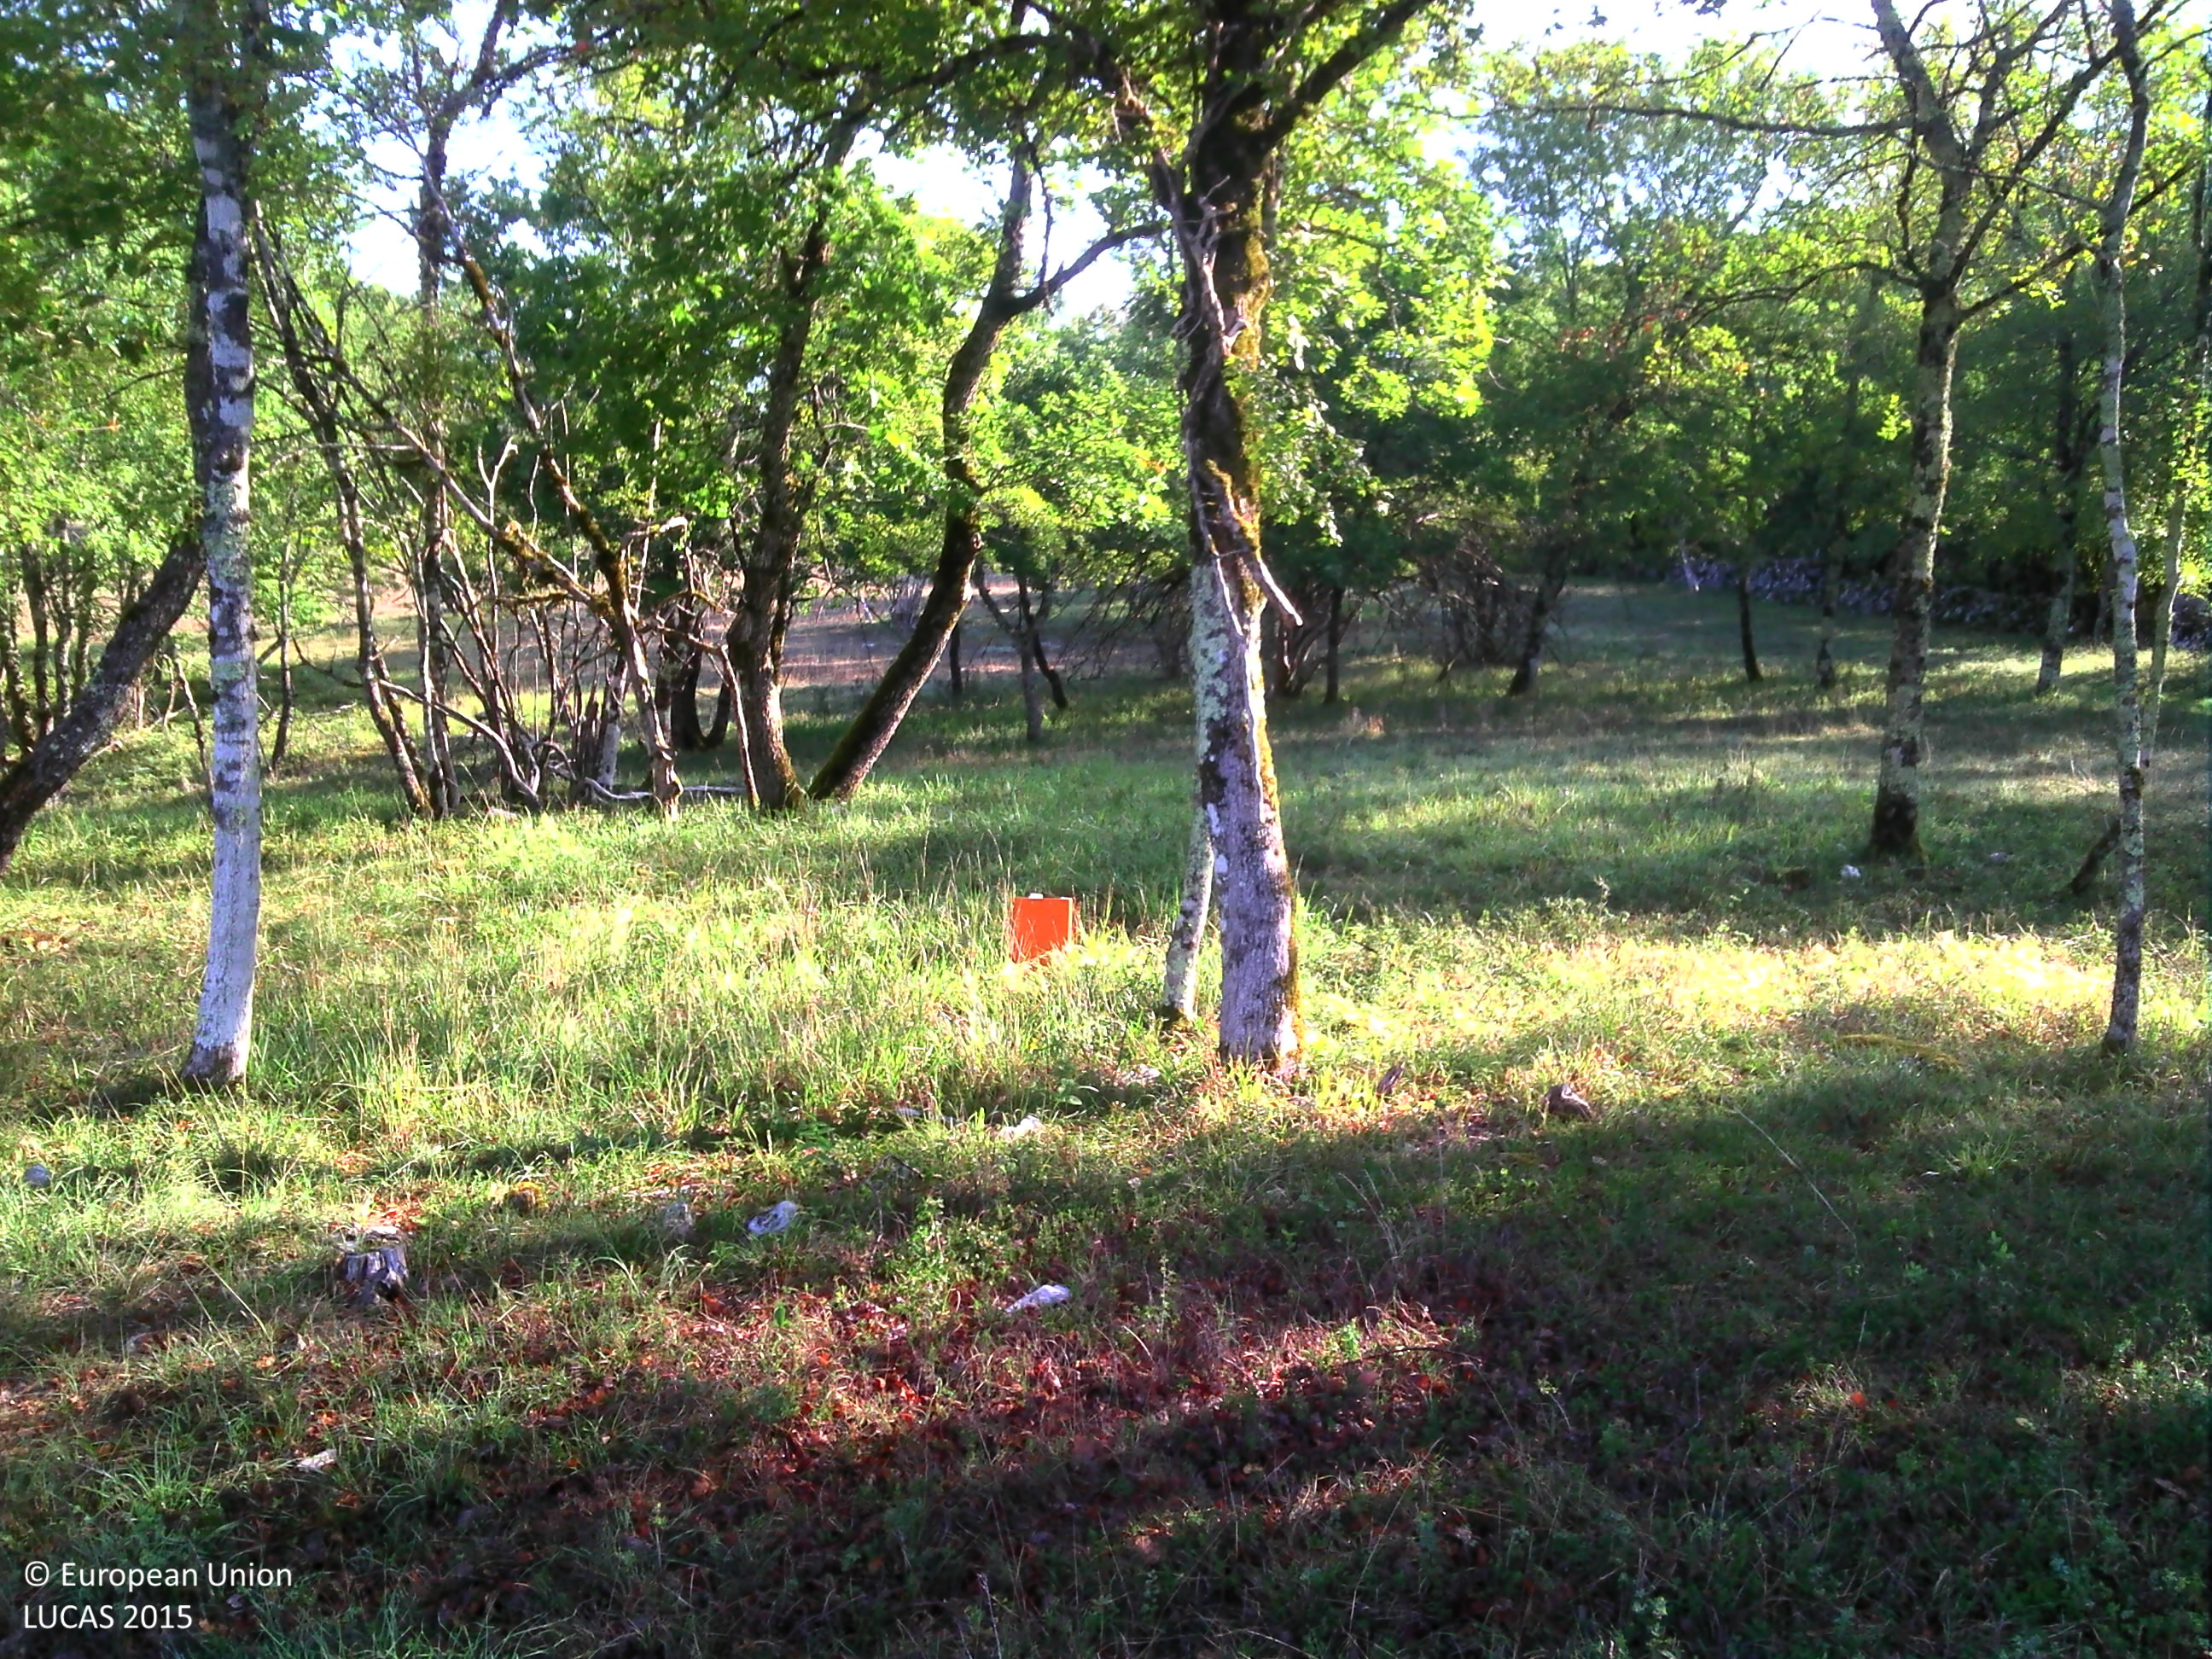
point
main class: Woodland
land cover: Broadleaved woodland
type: mesophytic deciduous forest
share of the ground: 50 - 75 %
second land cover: Grassland without tree/shrub cover
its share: 25 - 50 %
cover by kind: broadleaved forest trees 70 %, herbaceous plants 30 %
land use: Agriculture (excluding fallow land and kitchen gardens)
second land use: Forestry
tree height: > 5 m
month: September
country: FR
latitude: 44.6827
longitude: 1.6333
